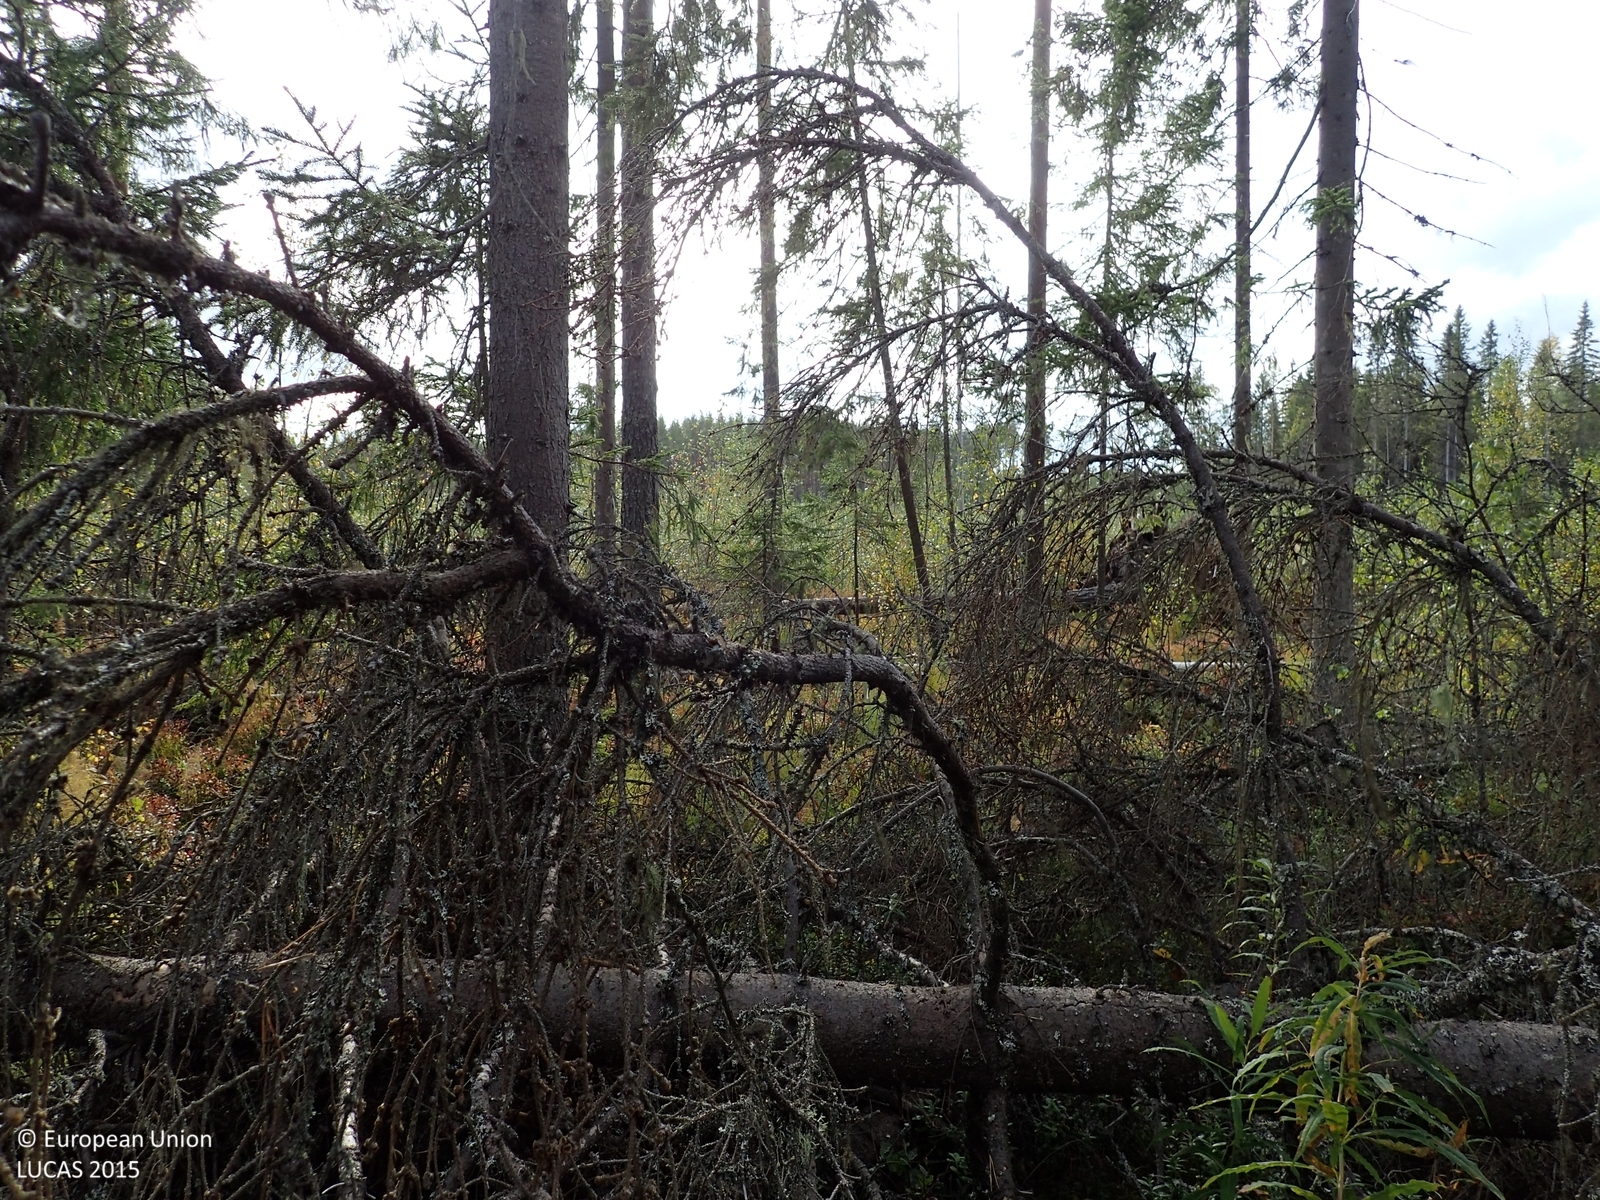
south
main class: Woodland
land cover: Other mixed woodland
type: boreal forest
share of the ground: > 75 %
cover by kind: coniferous forest trees 55 %, broadleaved forest trees 20 %, shrubs 15 %, herbaceous plants 10 %
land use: Forestry
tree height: > 5 m
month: September
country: FI
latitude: 63.0264
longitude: 25.2579
